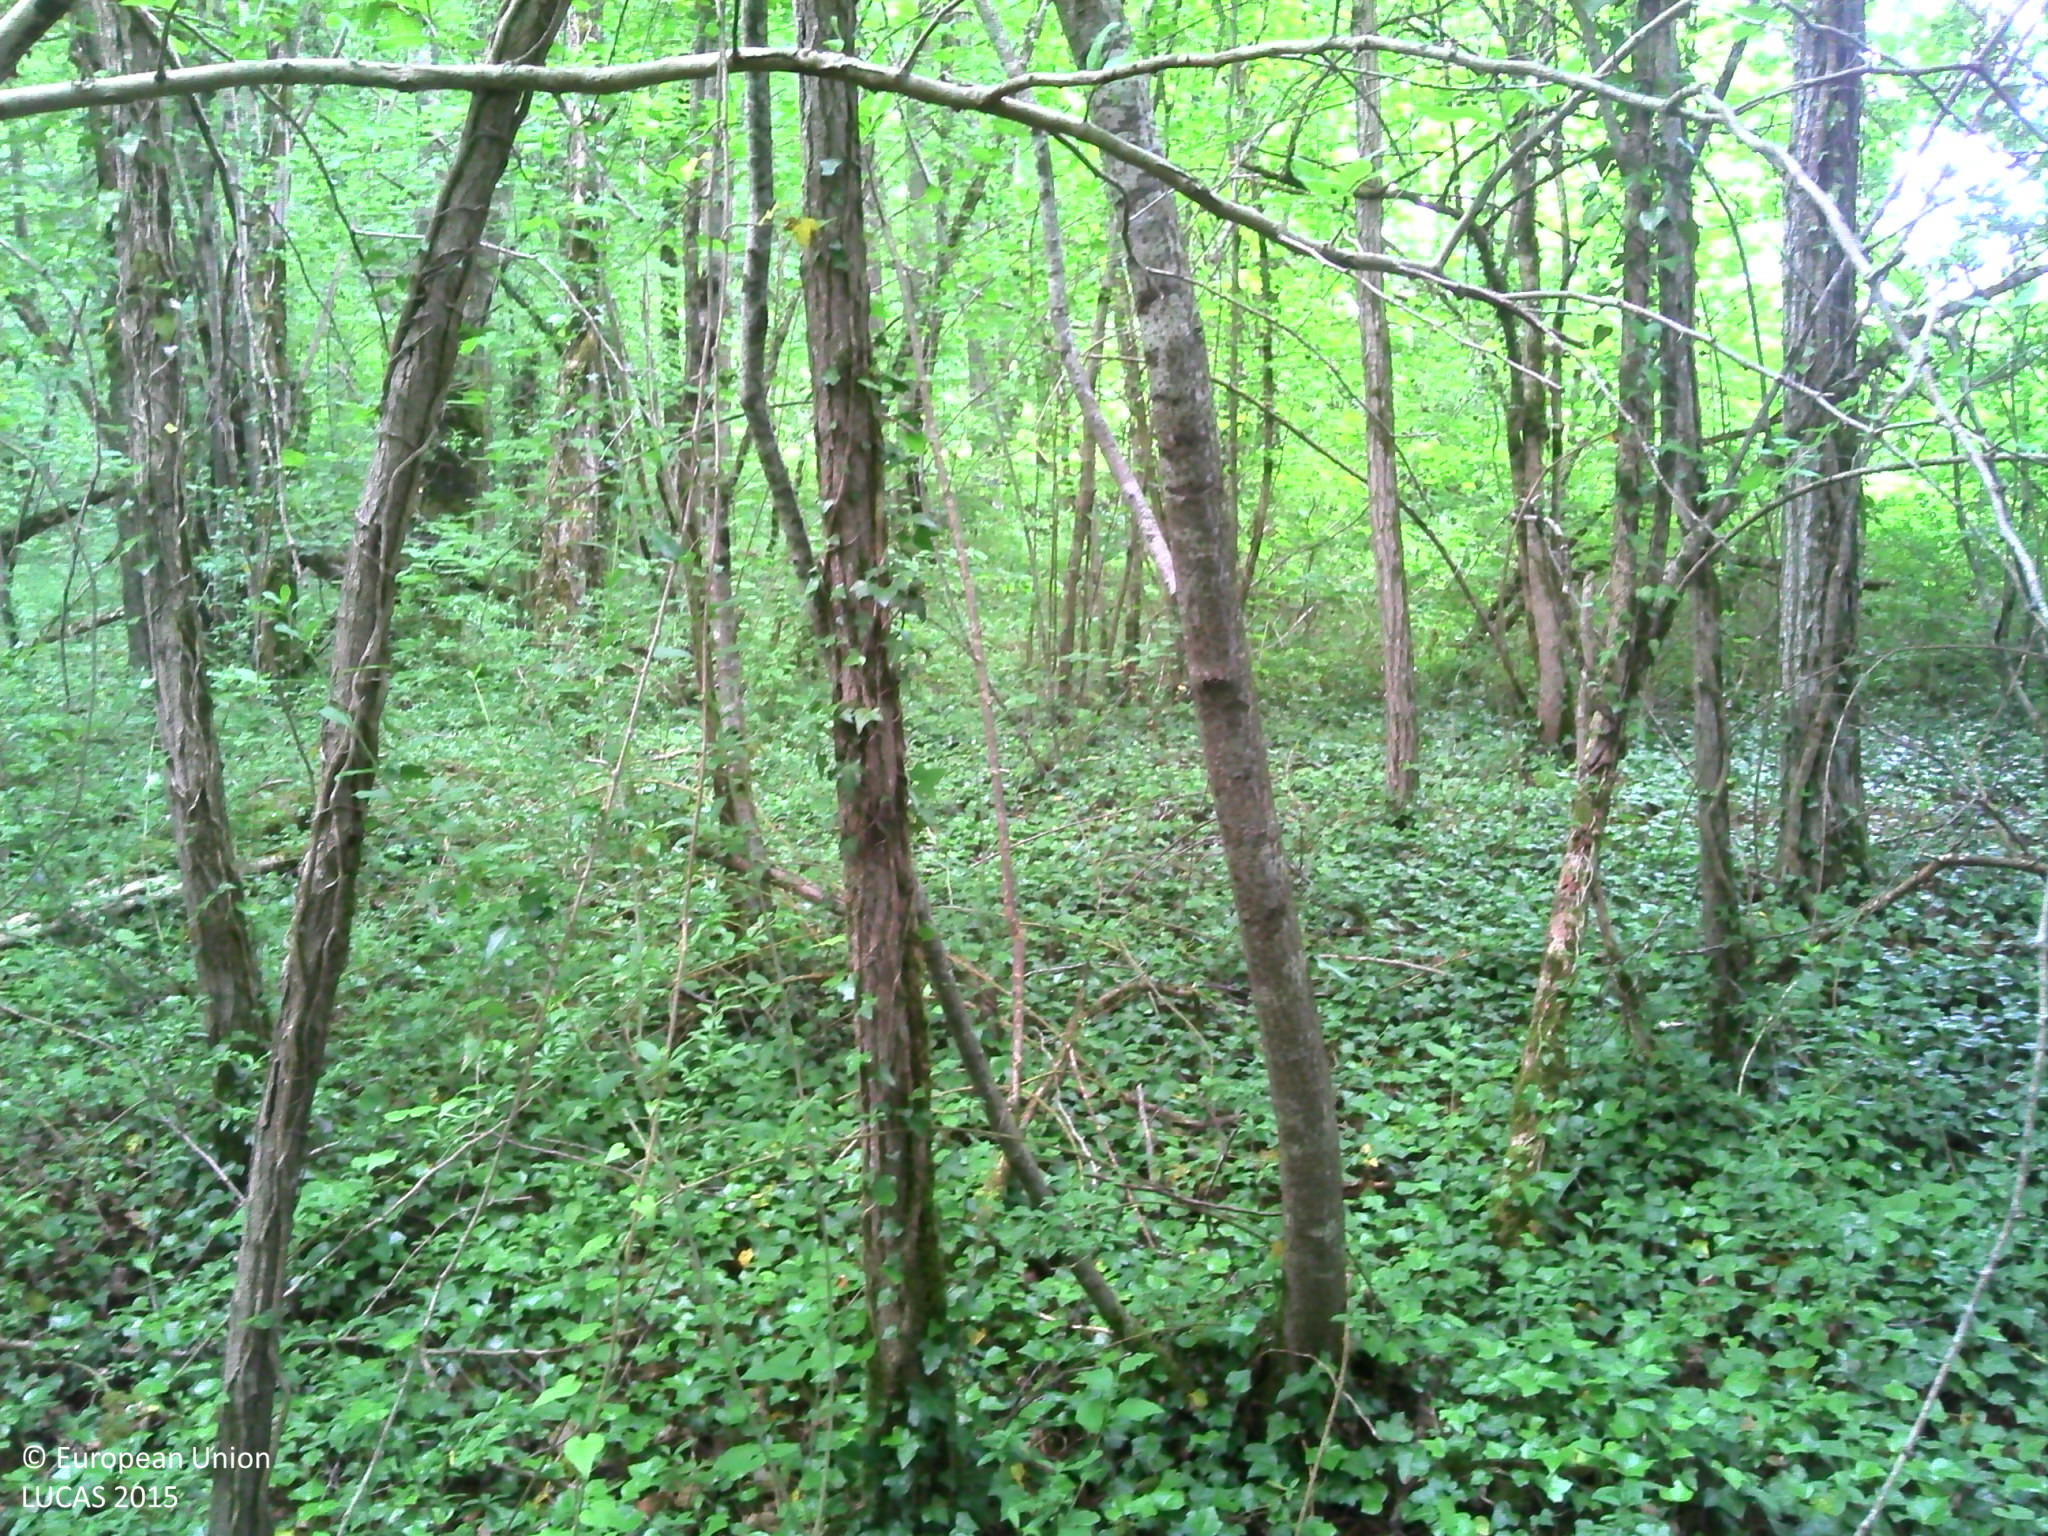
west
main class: Woodland
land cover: Broadleaved woodland
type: acidophilous oak and oak-birch forest
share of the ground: > 75 %
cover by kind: broadleaved forest trees 90 %, herbaceous plants 5 %, lichens and mosses 5 %
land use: Forestry
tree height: > 5 m
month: May
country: FR
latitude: 47.7860
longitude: 4.2718
